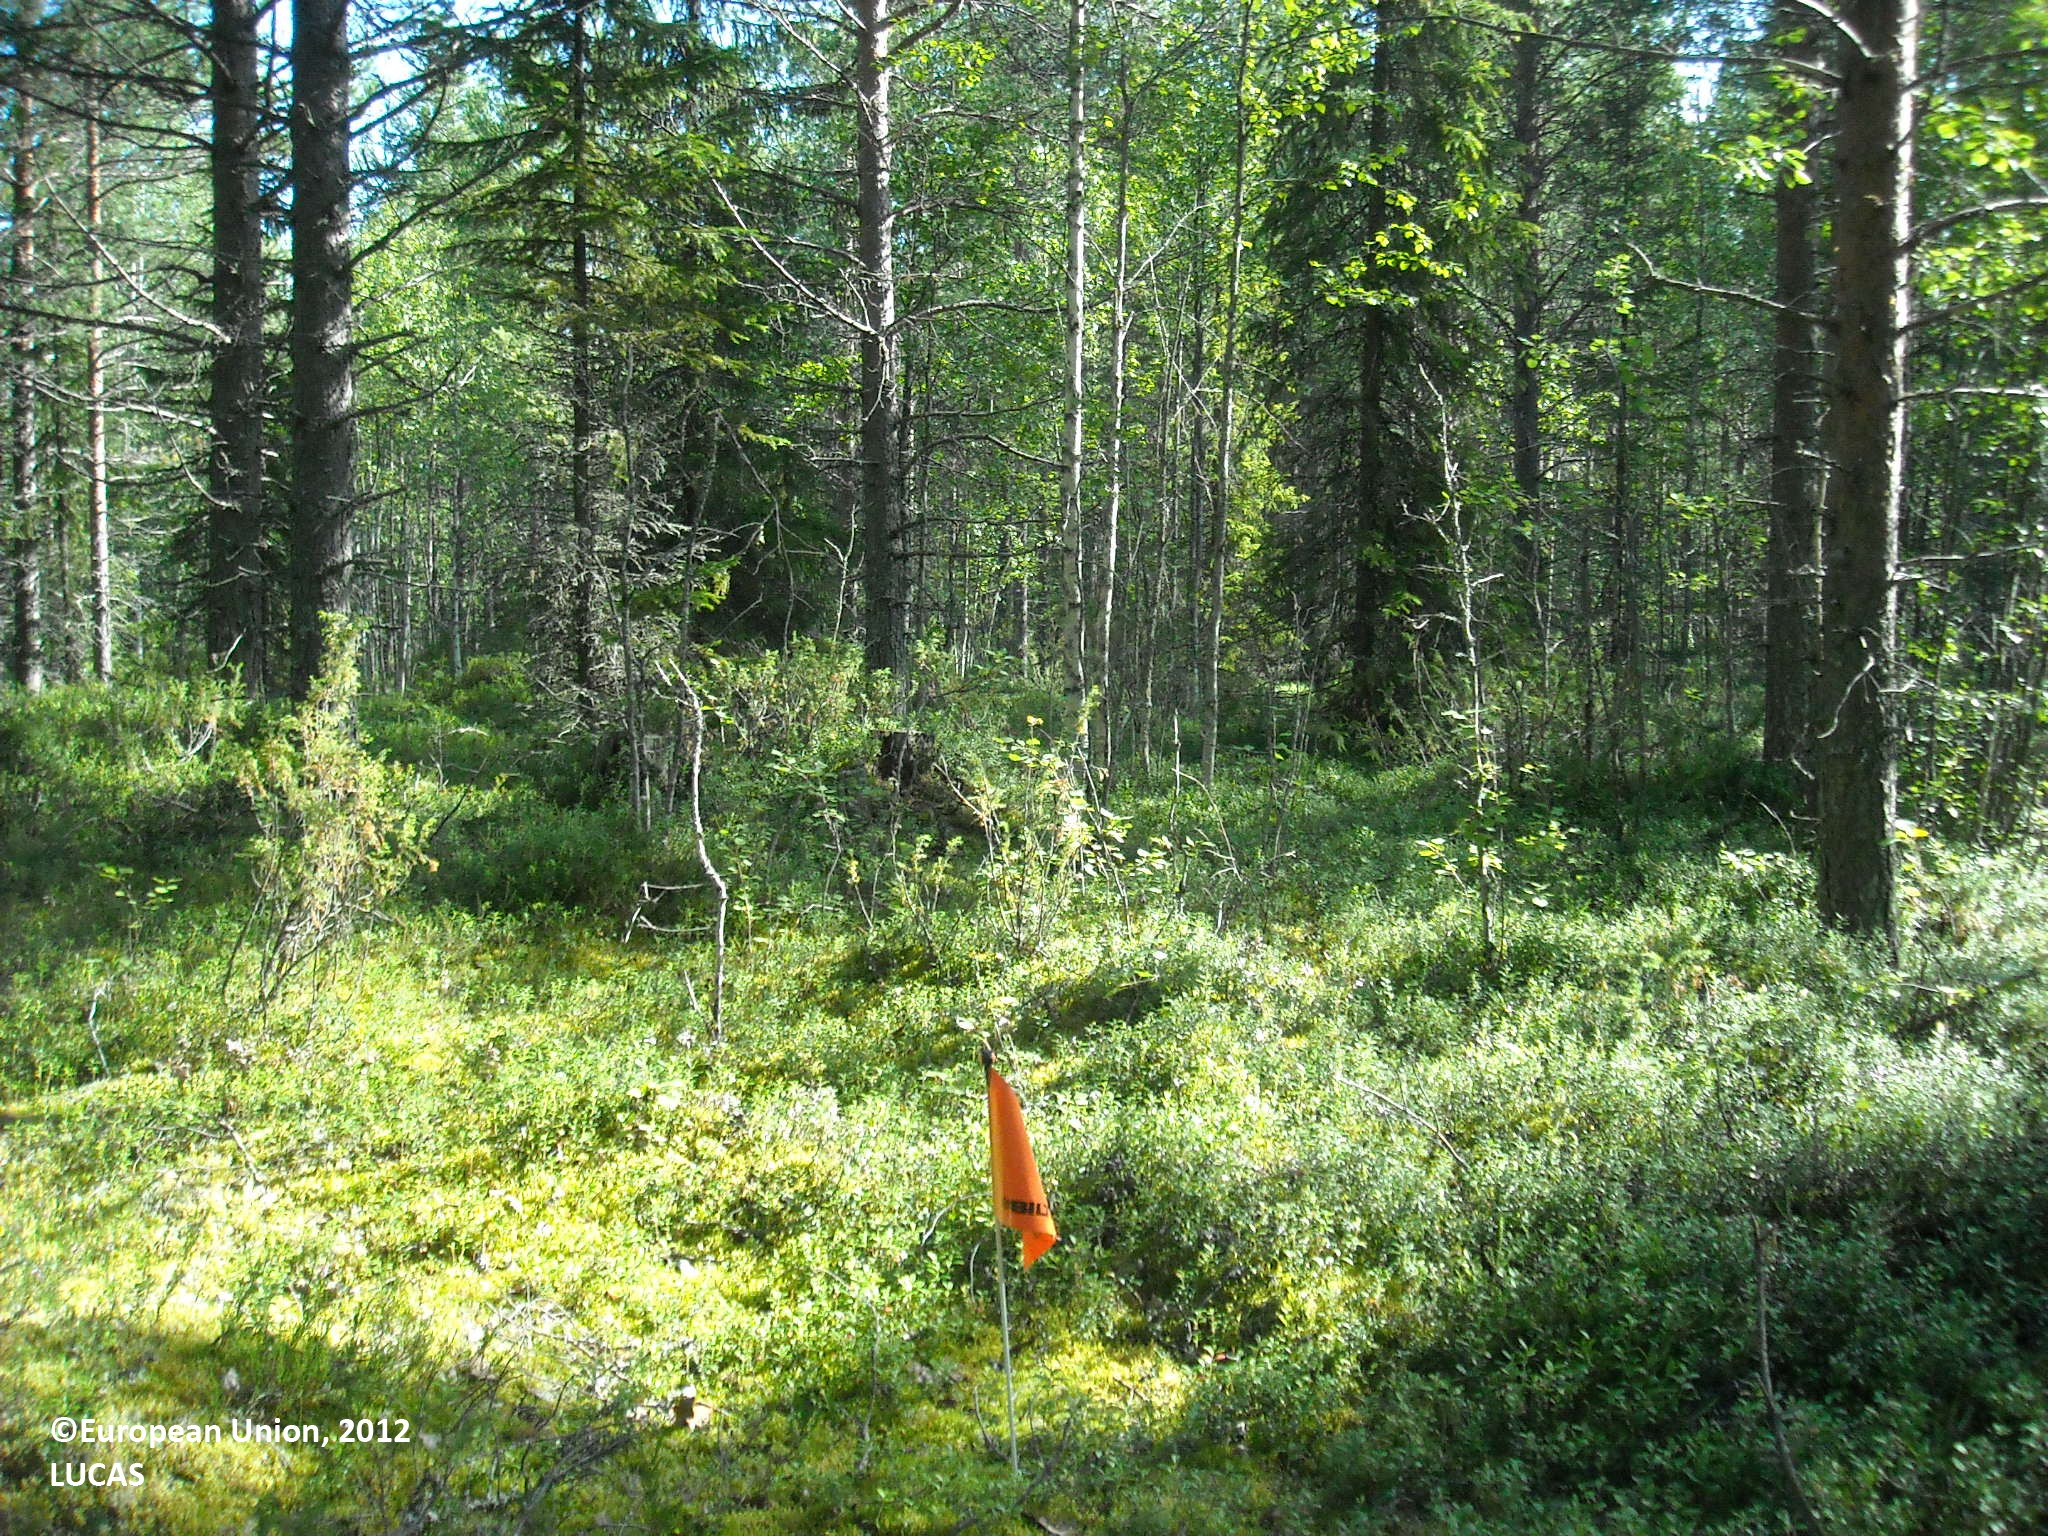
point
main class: Woodland
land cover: Other coniferous woodland
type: boreal forest
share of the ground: 50 - 75 %
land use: Forestry
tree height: > 5 m
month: August
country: FI
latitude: 65.1210
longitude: 27.7163
